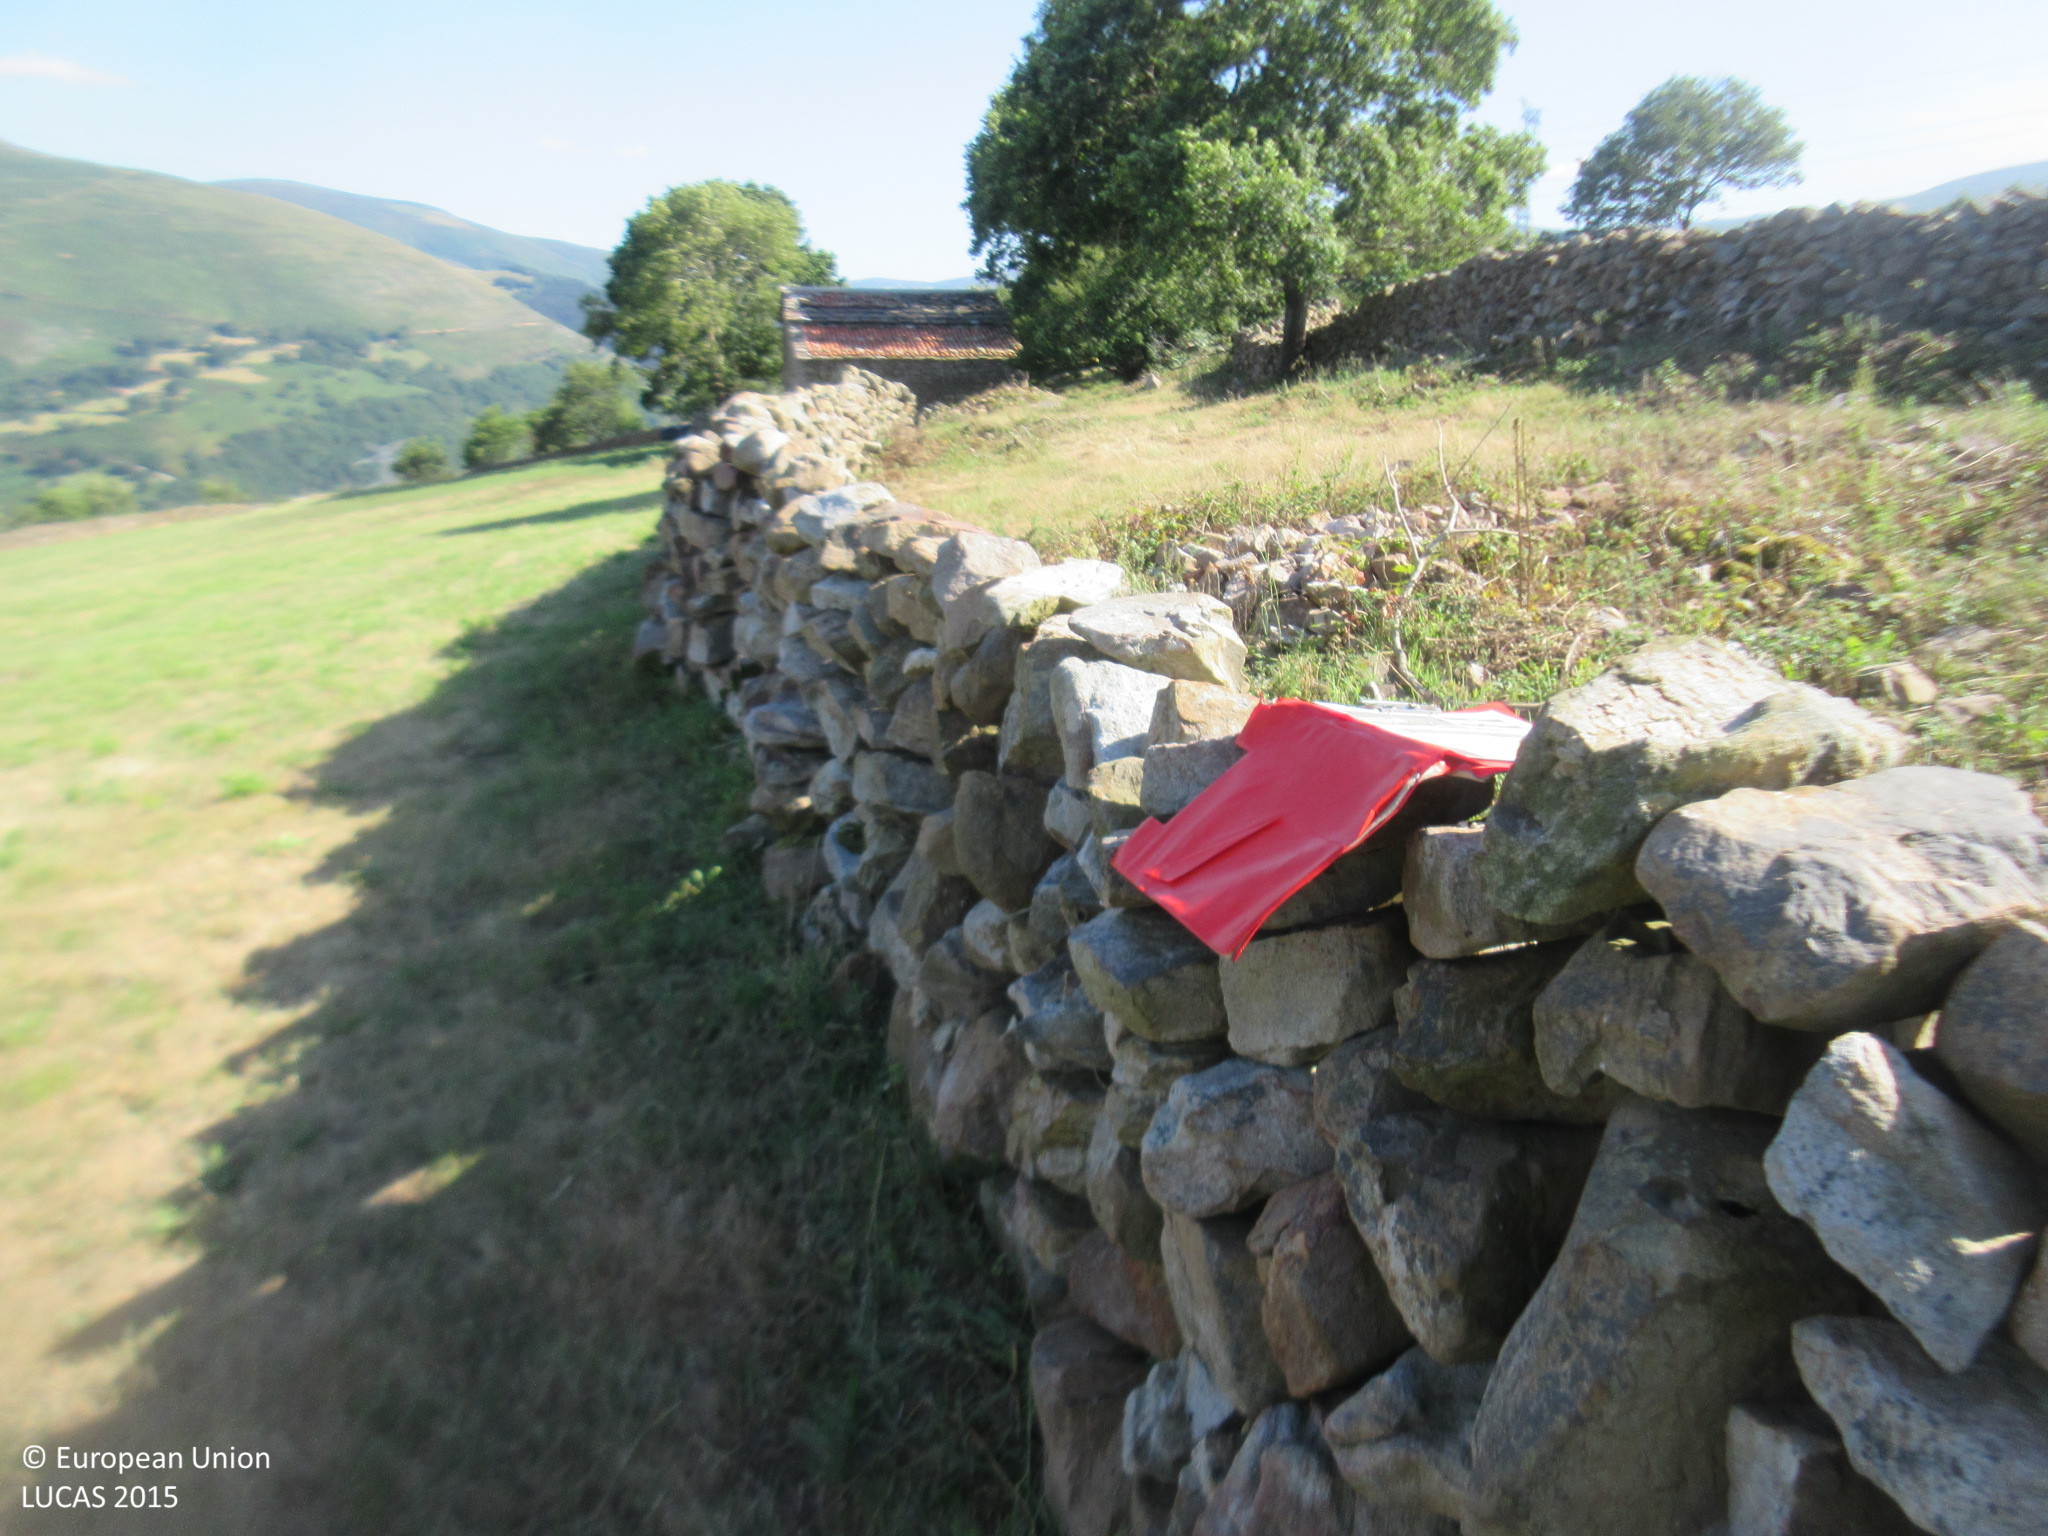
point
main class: Grassland
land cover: Grassland without tree/shrub cover
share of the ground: > 75 %
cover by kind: herbaceous plants 100 %
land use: Agriculture (excluding fallow land and kitchen gardens)
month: July
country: ES
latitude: 43.1529
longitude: -3.9068
